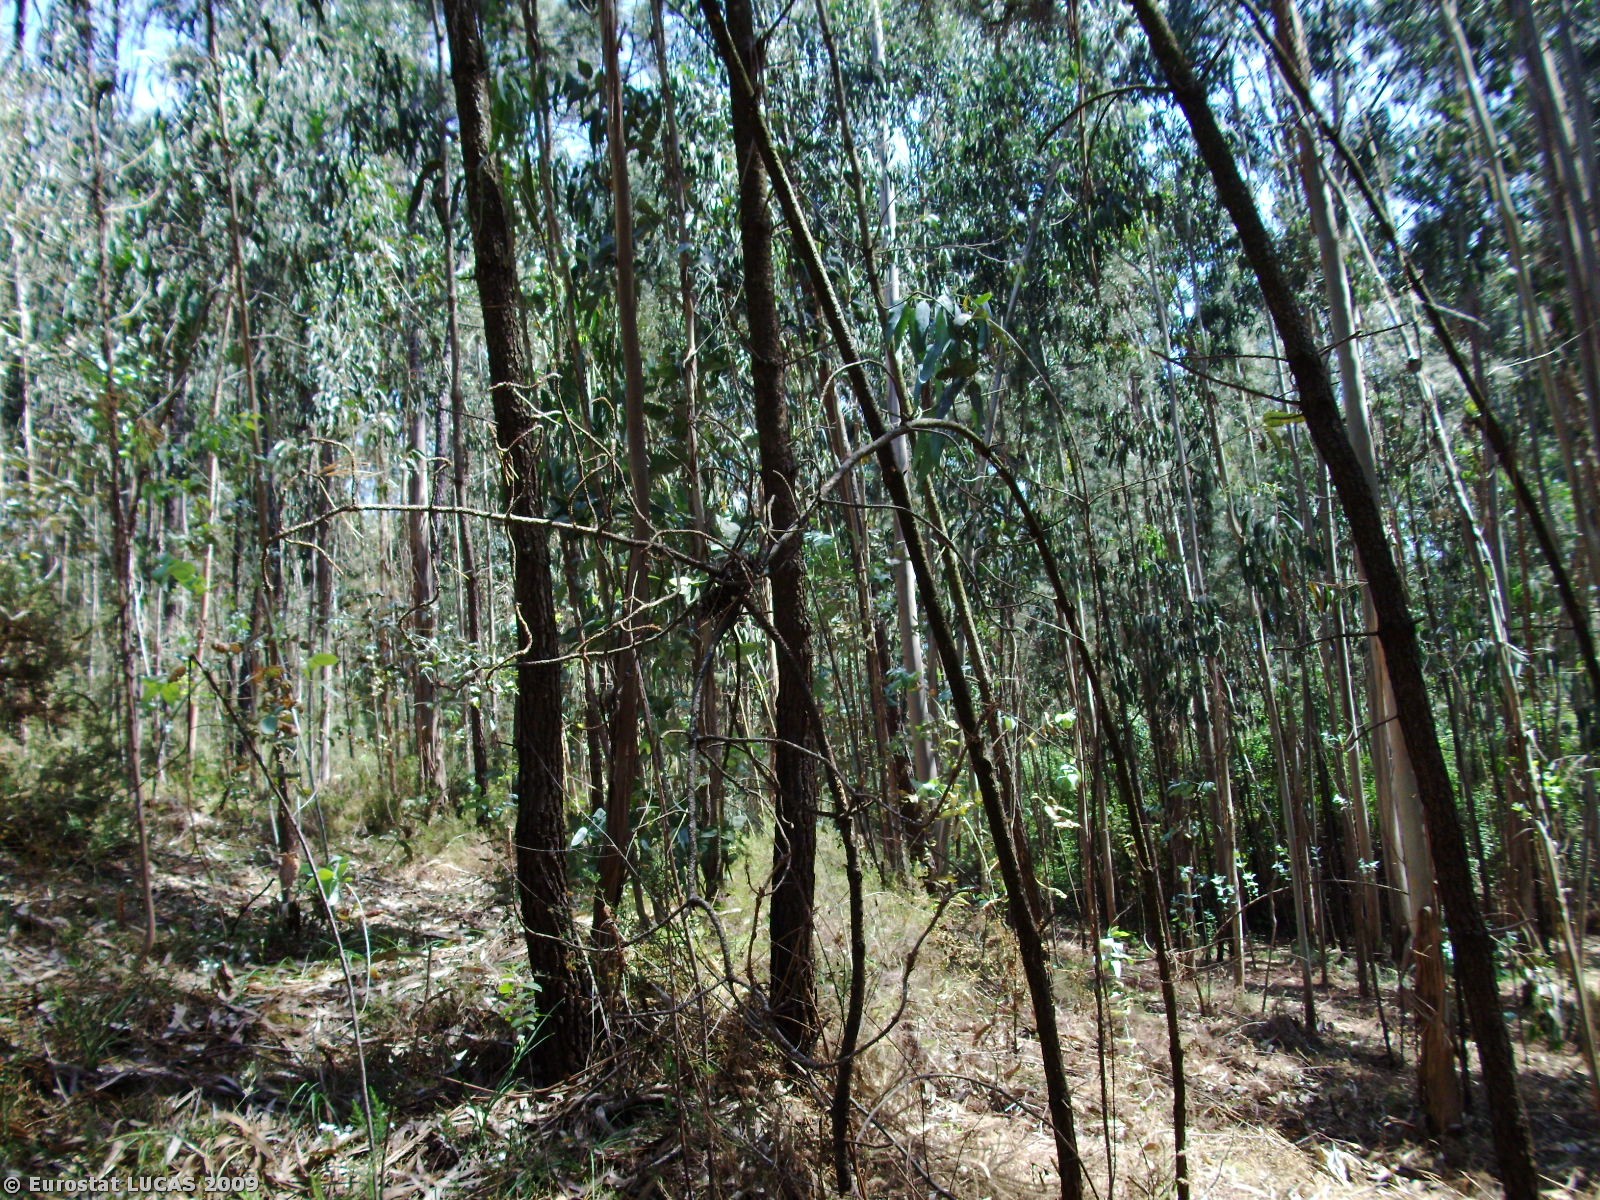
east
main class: Woodland
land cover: Mixed woodland
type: coniferous forest of the mediterranean region
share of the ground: > 75 %
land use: Forestry
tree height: > 5 m
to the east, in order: Mixed woodland; Broadleaved woodland; Rivers and streams; Broadleaved woodland
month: May
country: PT
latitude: 40.7670
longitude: -8.4933
